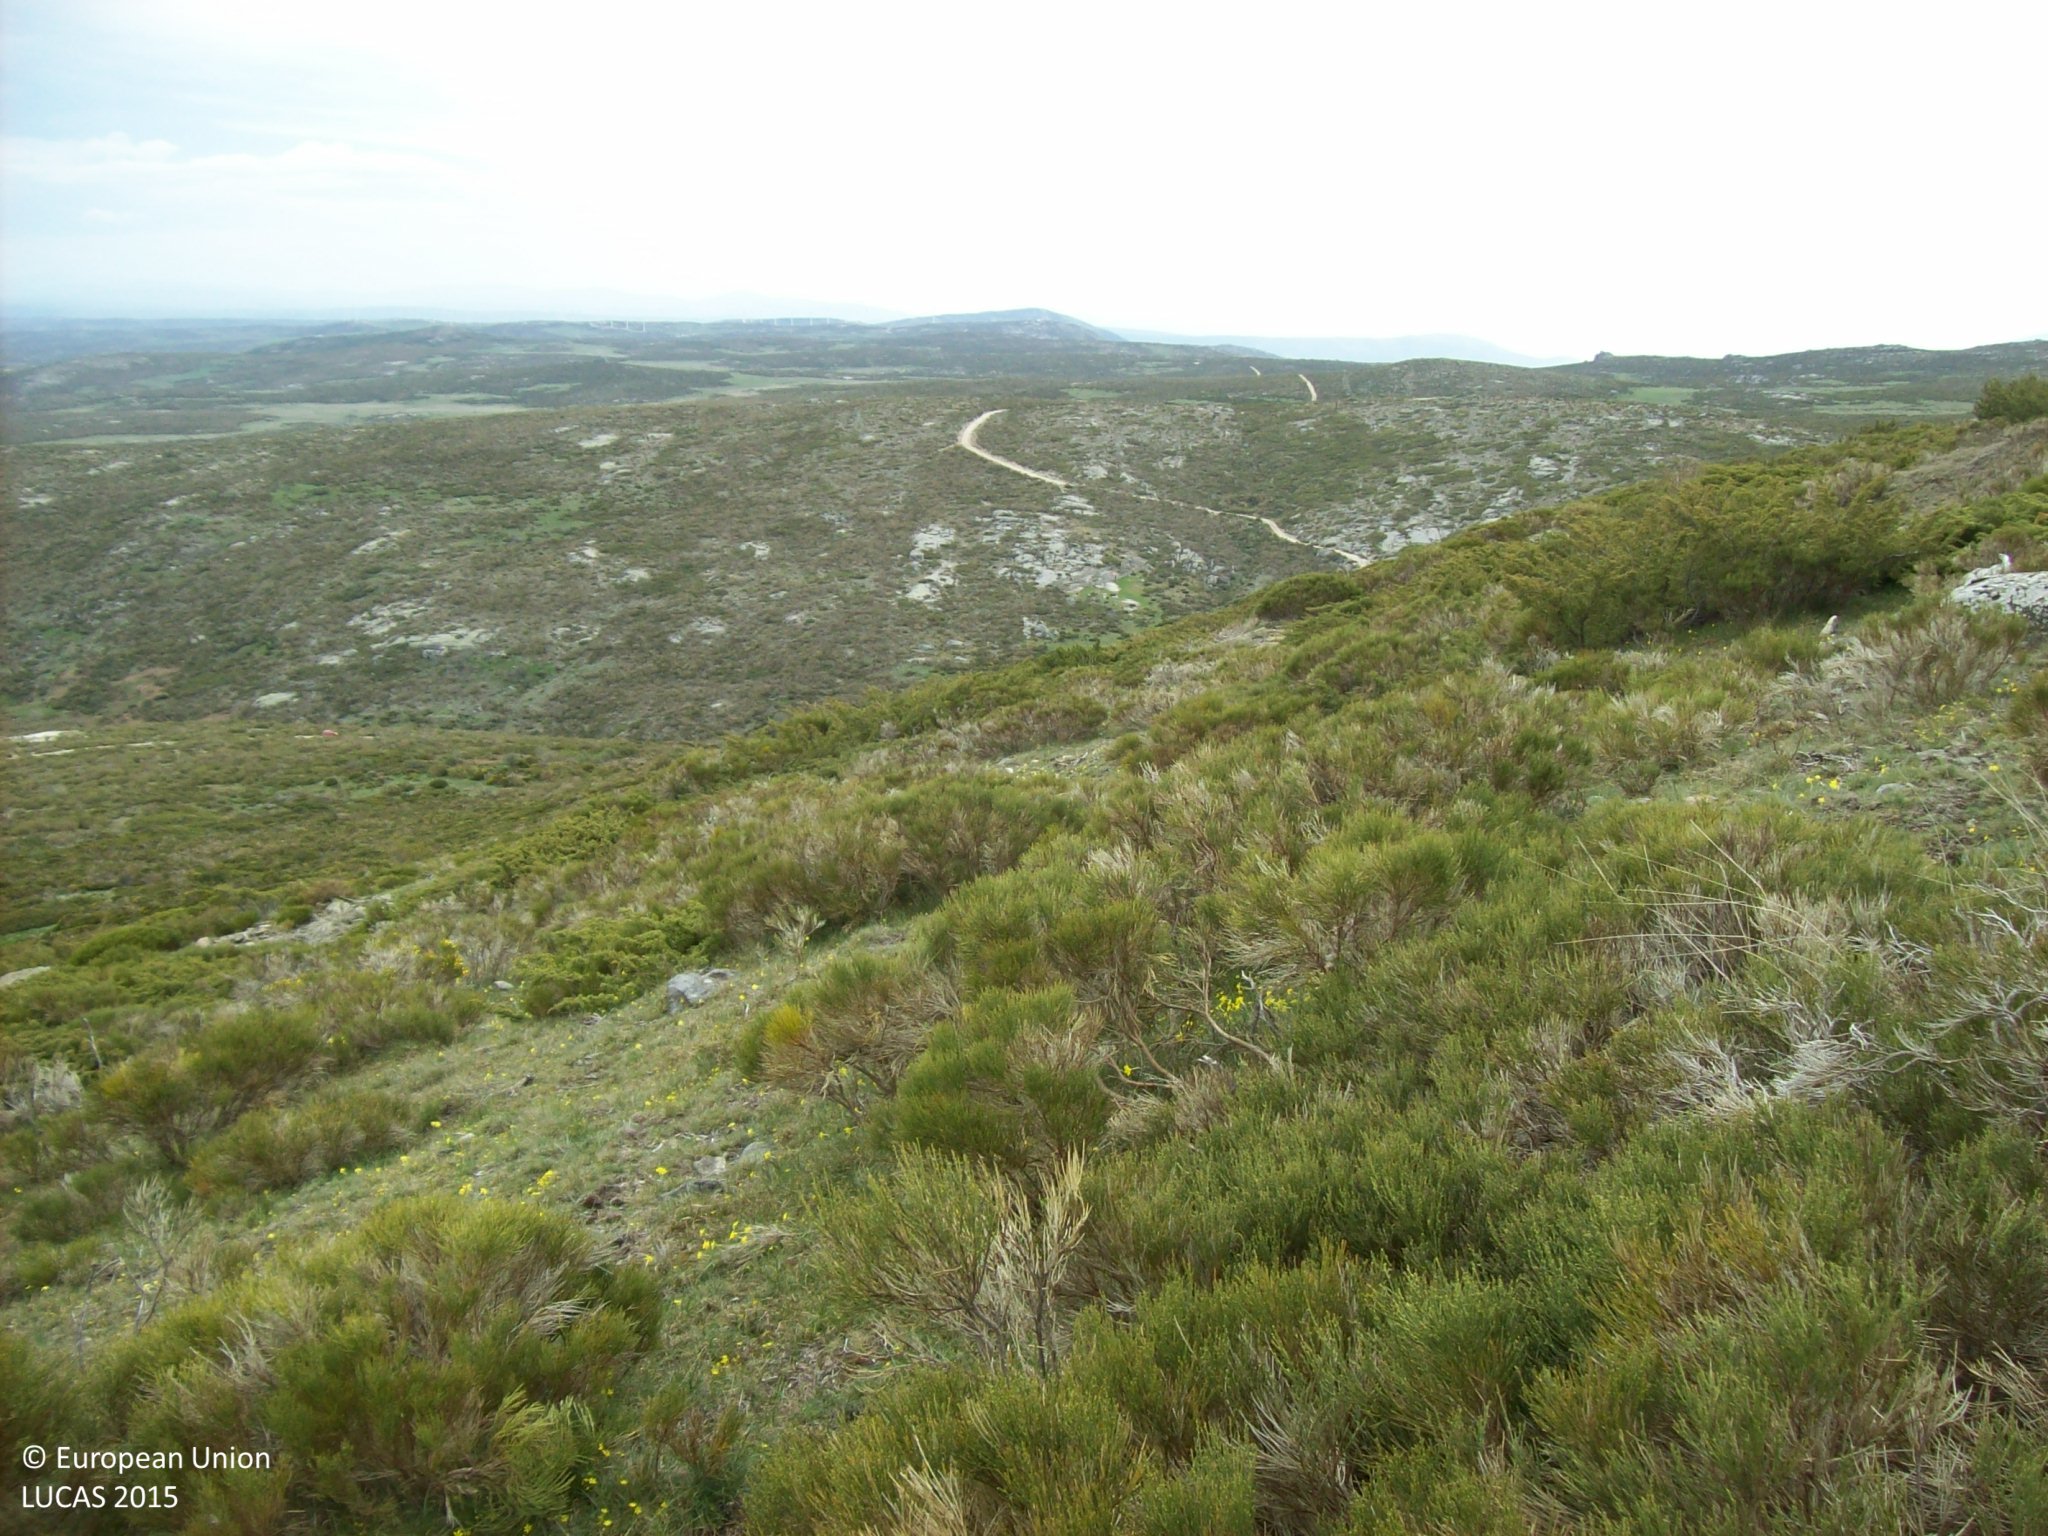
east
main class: Shrubland
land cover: Shrubland without tree cover
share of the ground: 25 - 50 %
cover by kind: herbaceous plants 50 %, shrubs 45 %, consolidated bare surface 5 %
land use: Agriculture (excluding fallow land and kitchen gardens)
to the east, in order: Shrubland without tree cover; Rock outcrops; Shrubland without tree cover
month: May
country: ES
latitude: 40.4938
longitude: -4.8154
